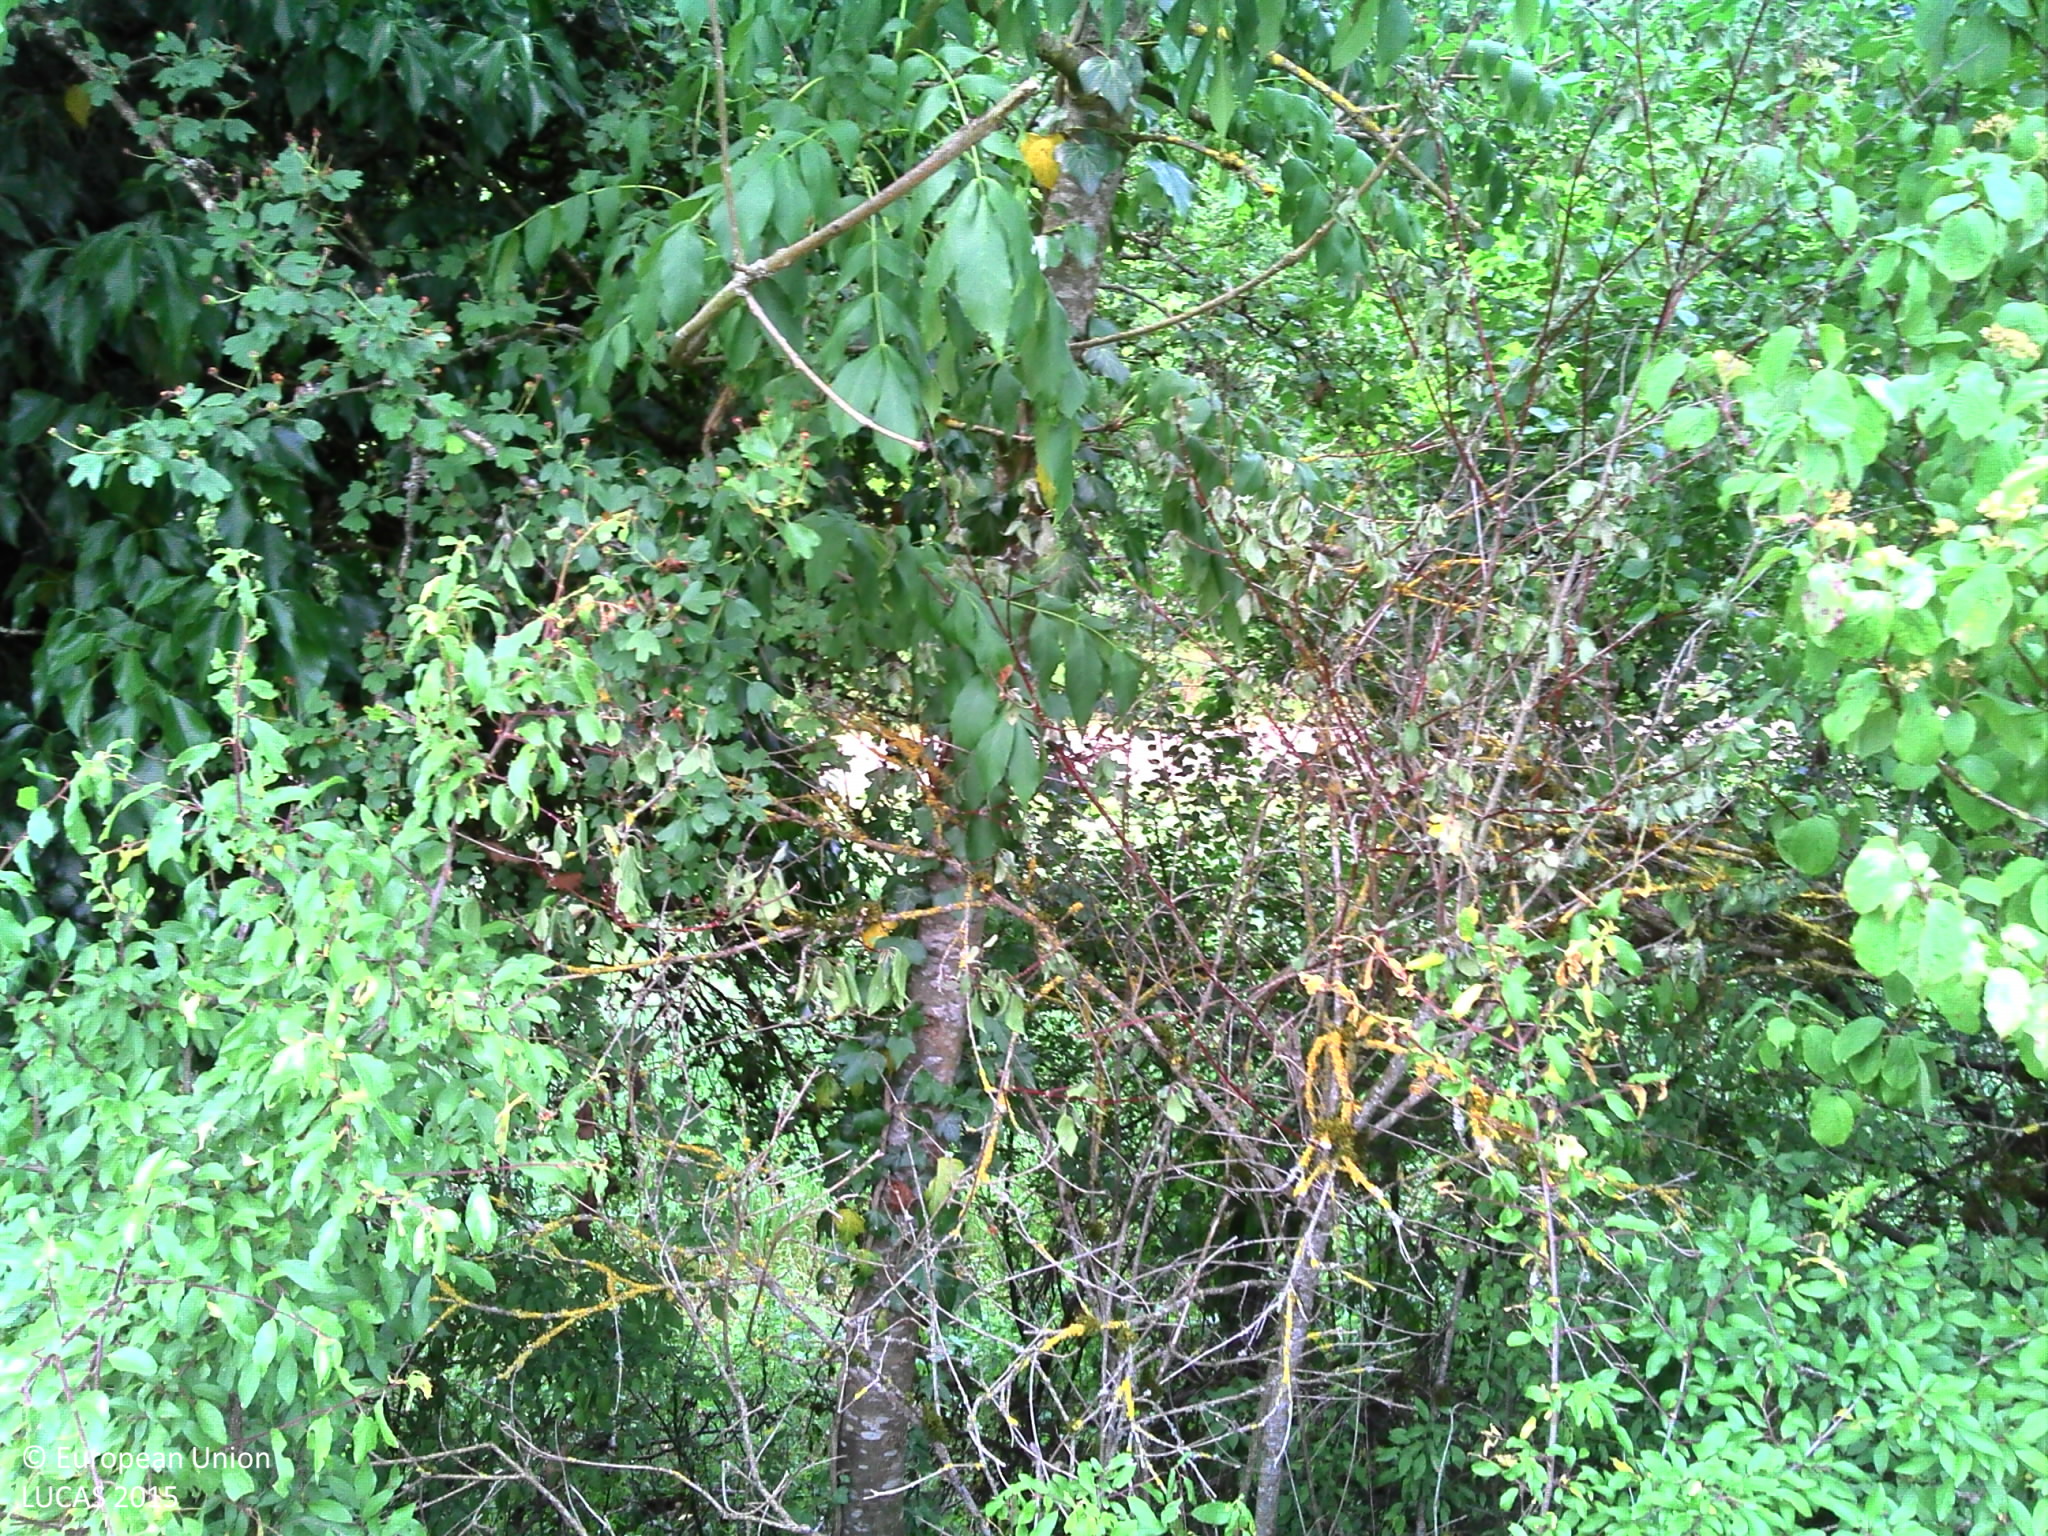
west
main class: Woodland
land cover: Broadleaved woodland
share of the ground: > 75 %
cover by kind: broadleaved forest trees 95 %, shrubs 5 %
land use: Semi-natural and natural areas not in use
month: June
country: FR
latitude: 47.5962
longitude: 5.1991
